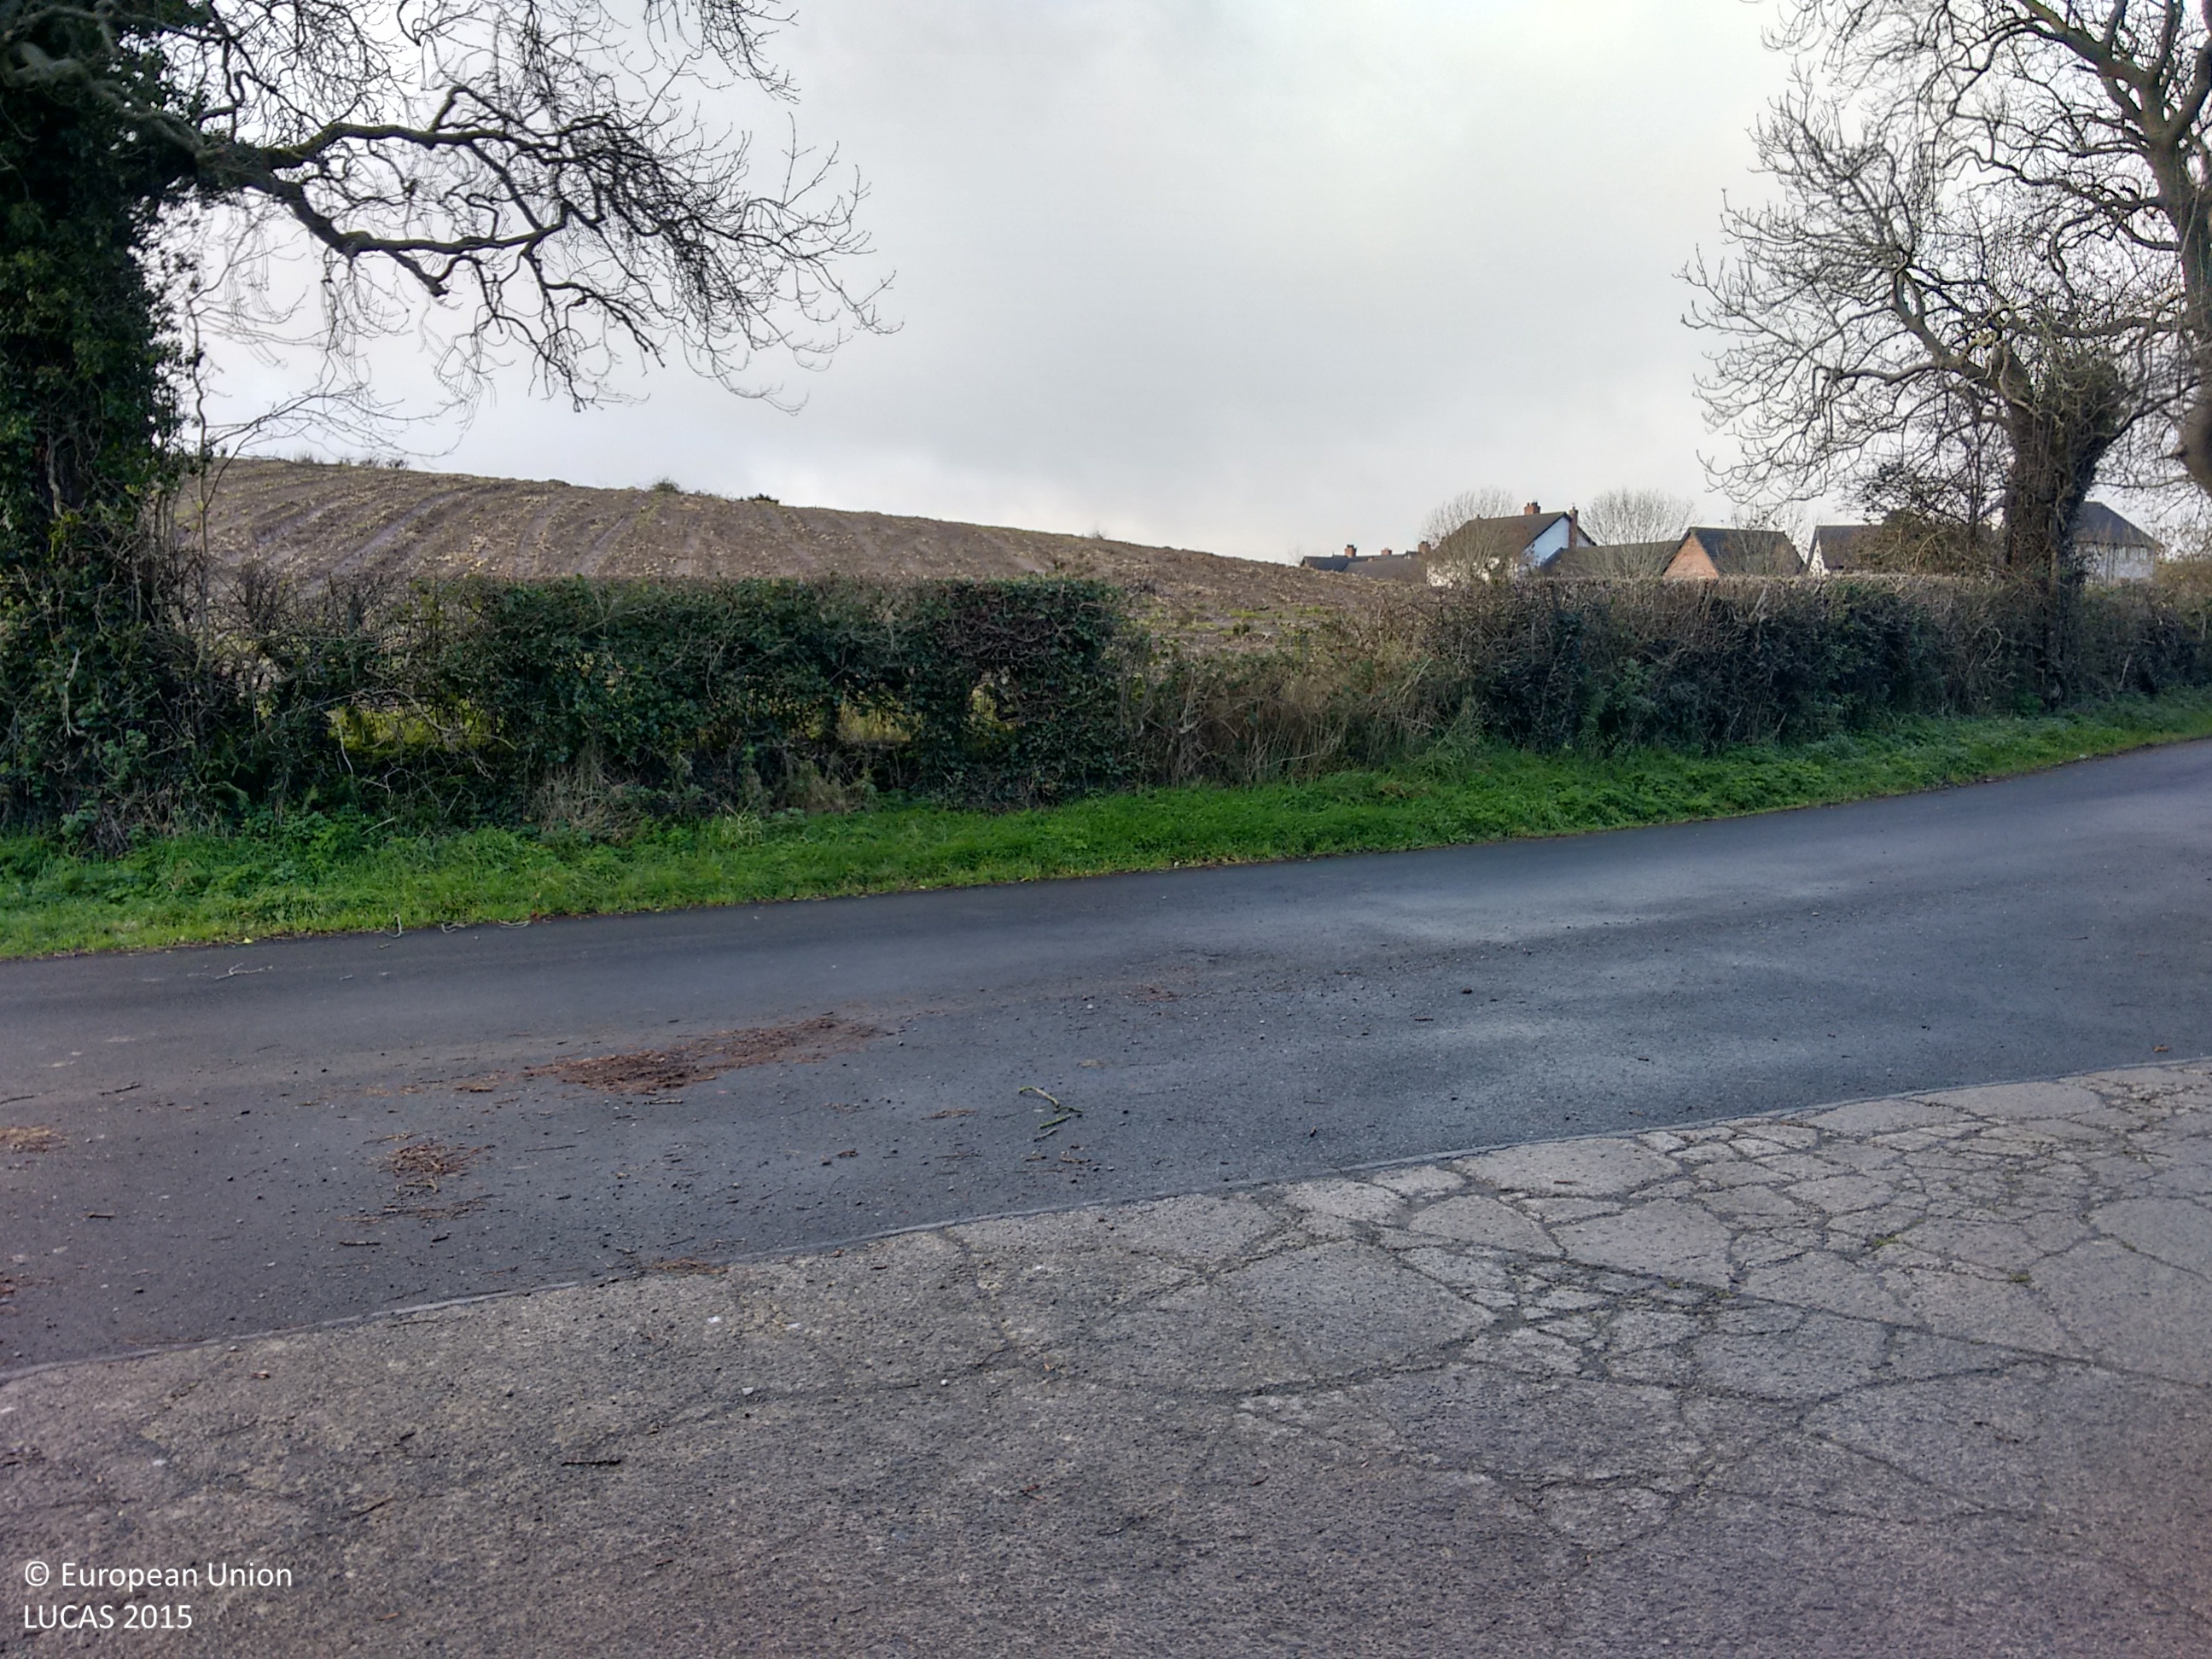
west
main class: Grassland
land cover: Grassland without tree/shrub cover
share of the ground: > 75 %
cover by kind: herbaceous plants 100 %
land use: Agriculture (excluding fallow land and kitchen gardens)
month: November
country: GB
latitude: 54.5940
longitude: -5.6546
